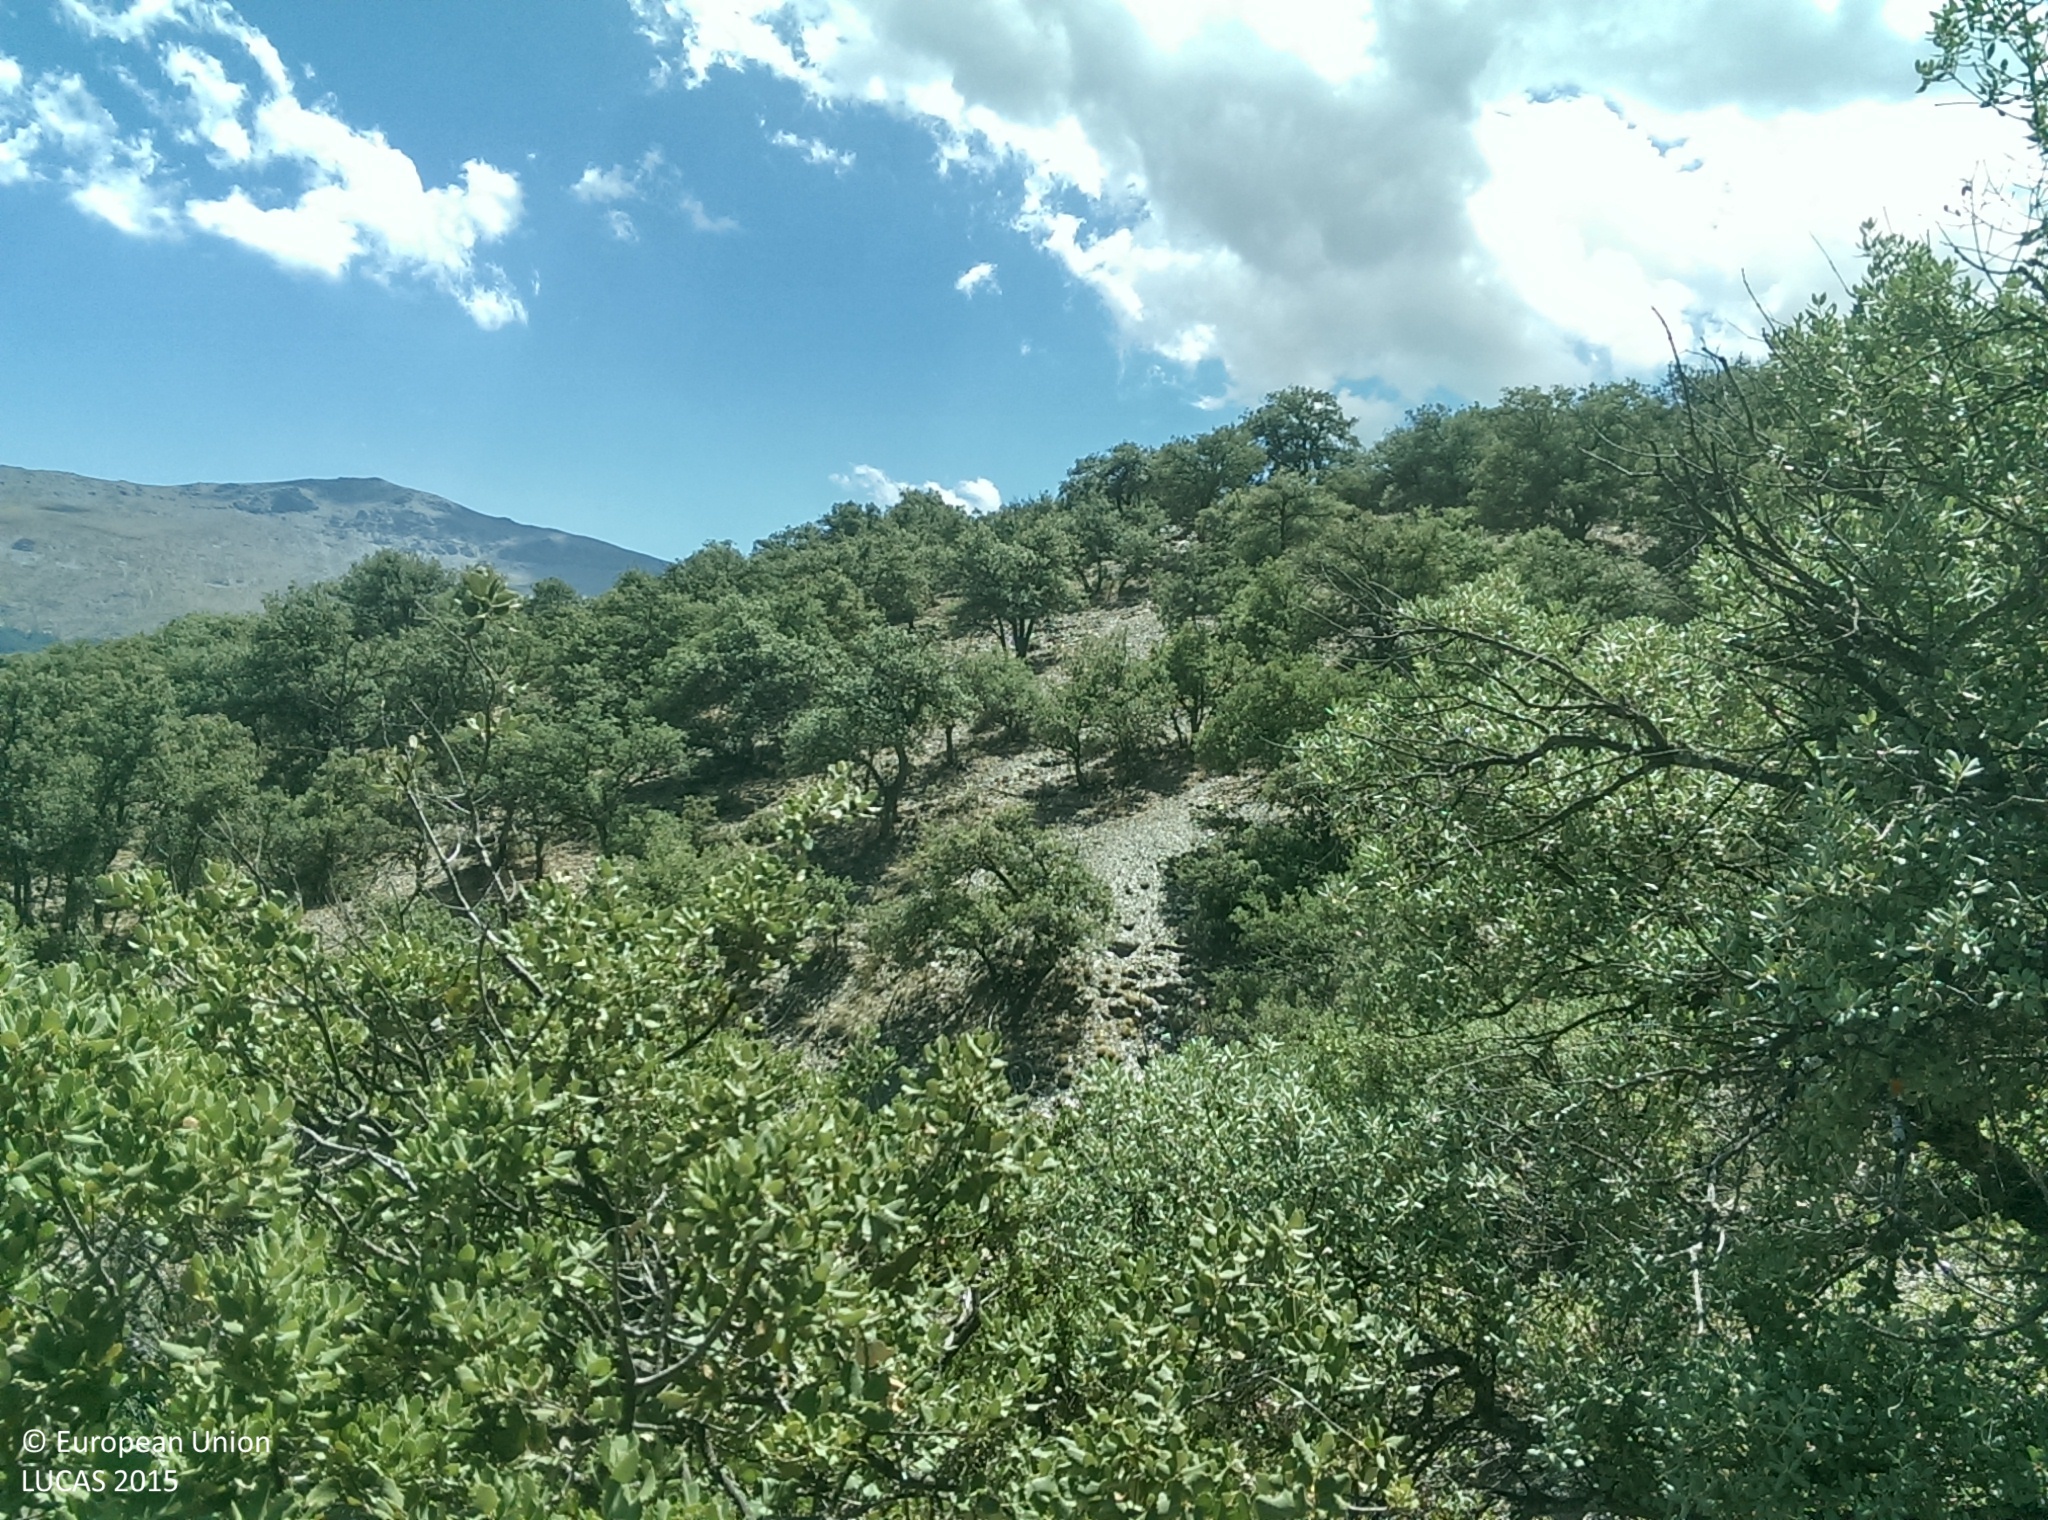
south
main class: Woodland
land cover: Broadleaved woodland
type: broadleaved evergreen forest
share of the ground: 50 - 75 %
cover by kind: broadleaved forest trees 60 %, consolidated bare surface 15 %, shrubs 10 %, unconsolidated bare surface 10 %, herbaceous plants 5 %
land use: Semi-natural and natural areas not in use
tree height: < 5 m
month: July
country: ES
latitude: 37.1519
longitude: -3.0791
